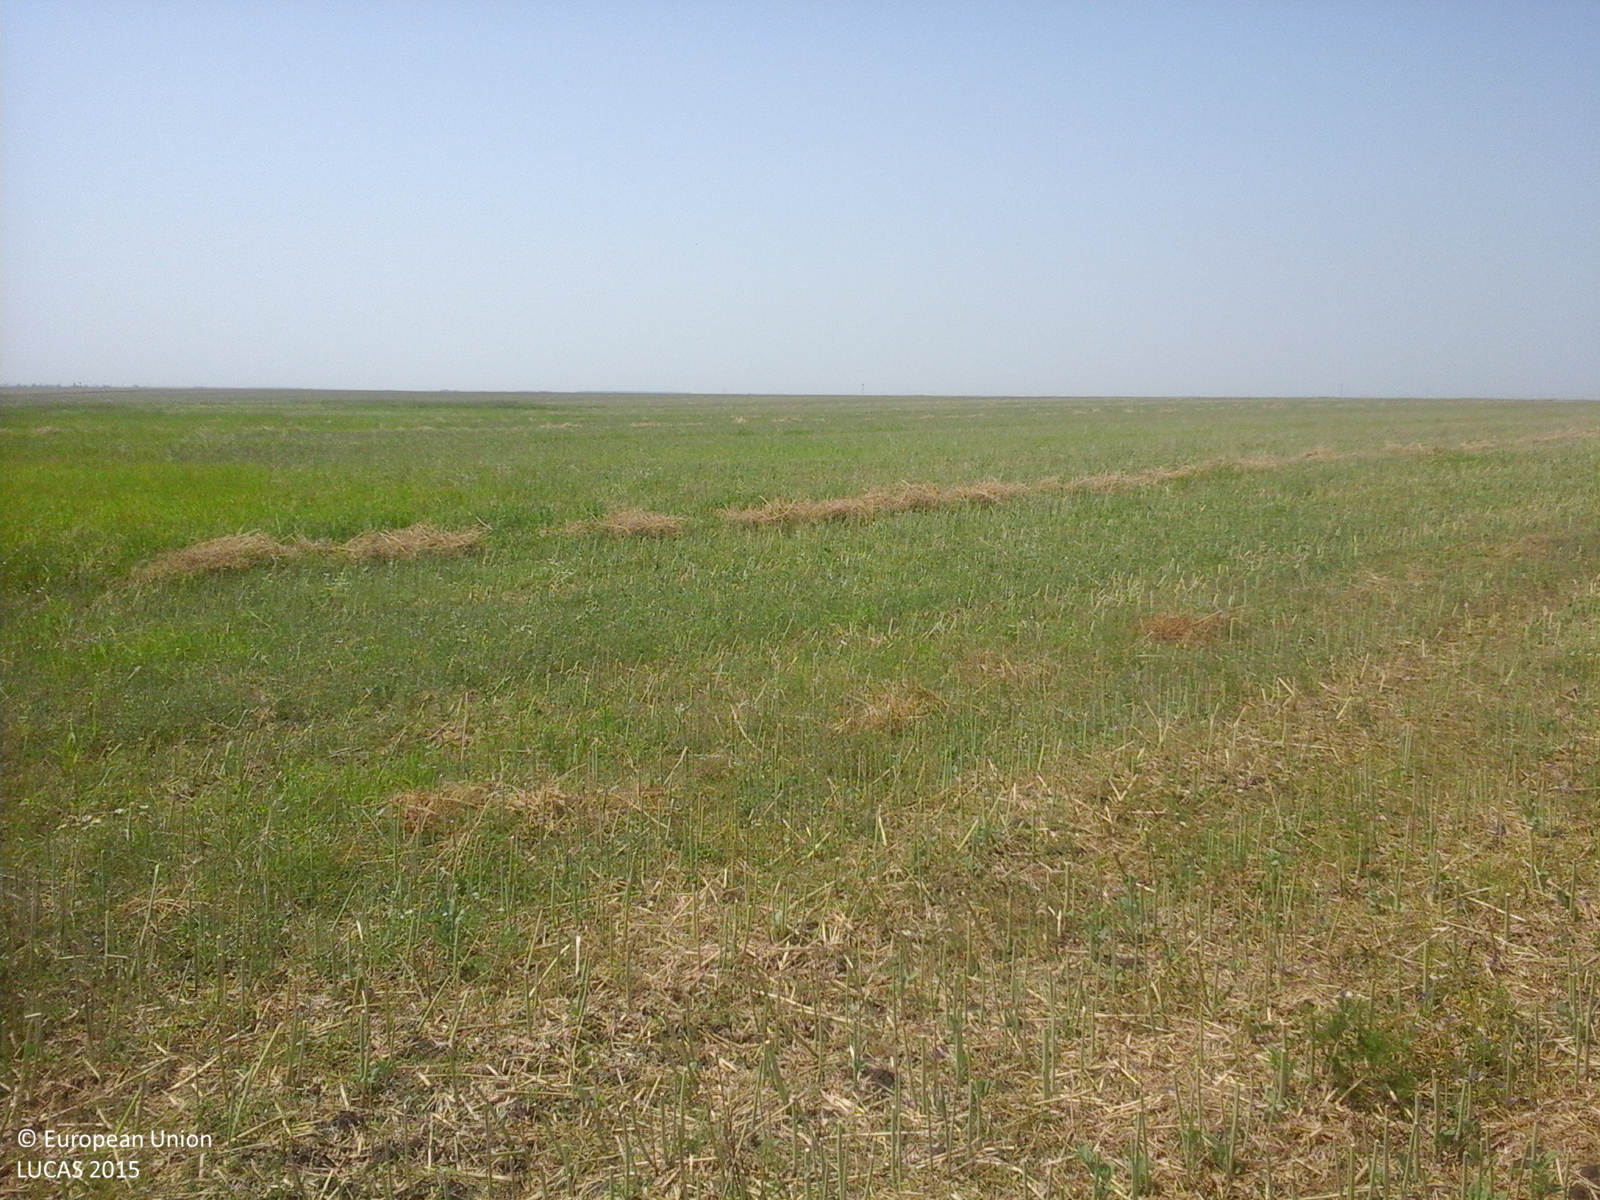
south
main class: Cropland
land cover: Rape and turnip rape
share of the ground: 10 - 25 %
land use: Agriculture (excluding fallow land and kitchen gardens)
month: July
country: RO
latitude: 44.4518
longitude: 24.8175
